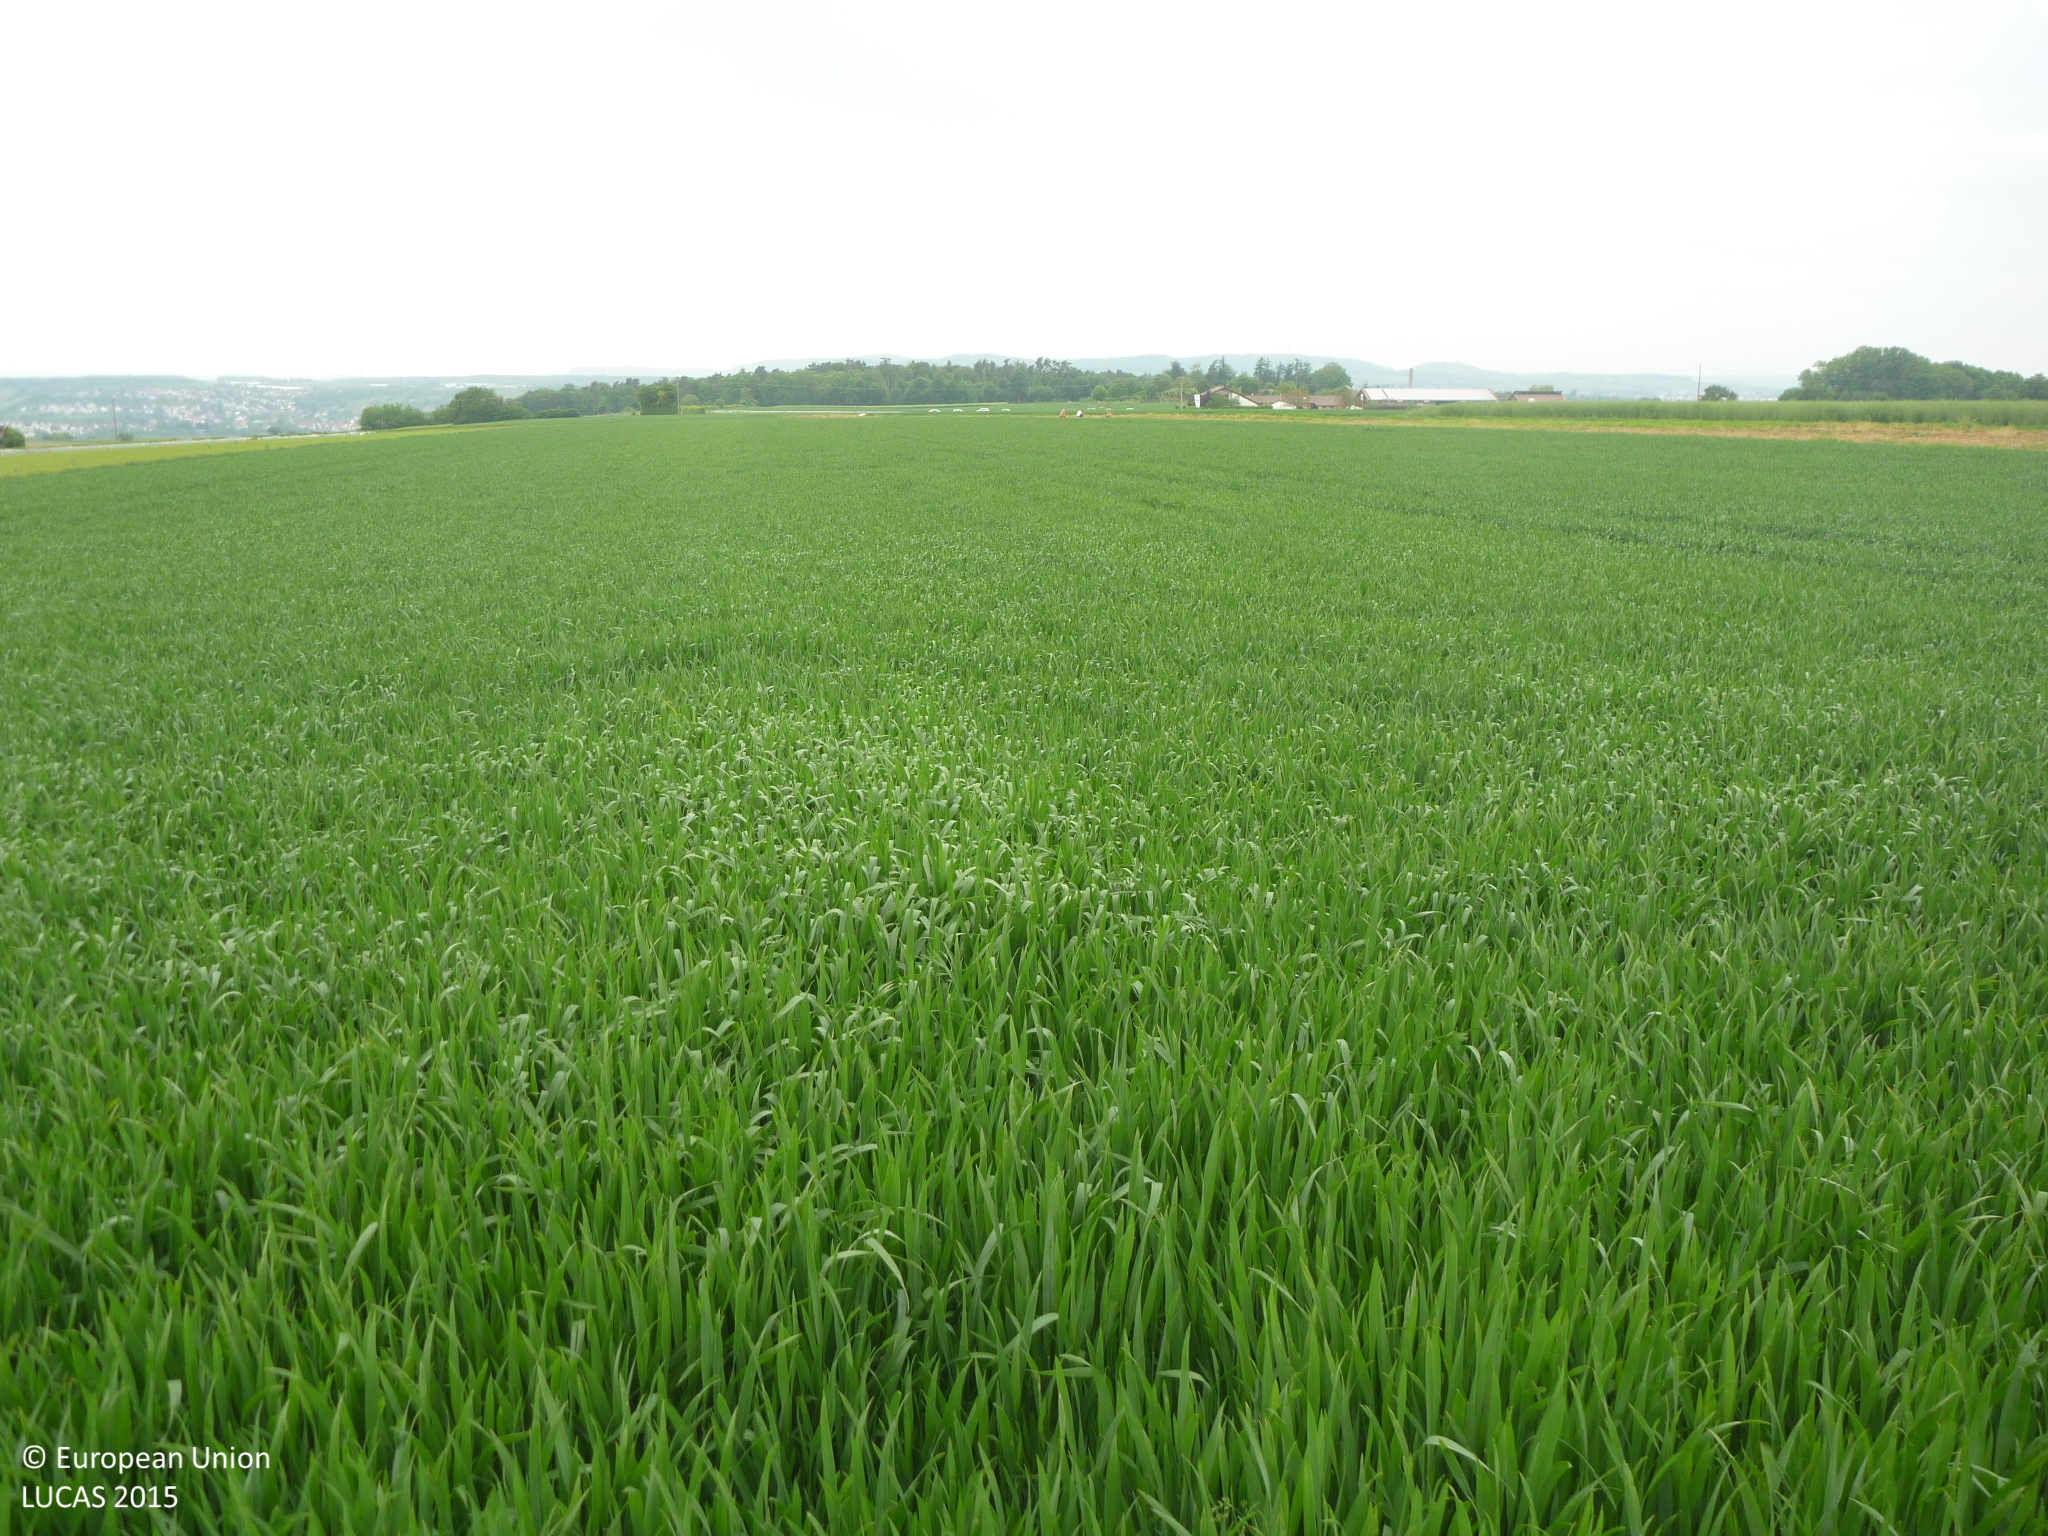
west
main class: Cropland
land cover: Common wheat
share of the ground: > 75 %
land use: Agriculture (excluding fallow land and kitchen gardens)
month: May
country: DE
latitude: 49.0123
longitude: 9.1937
